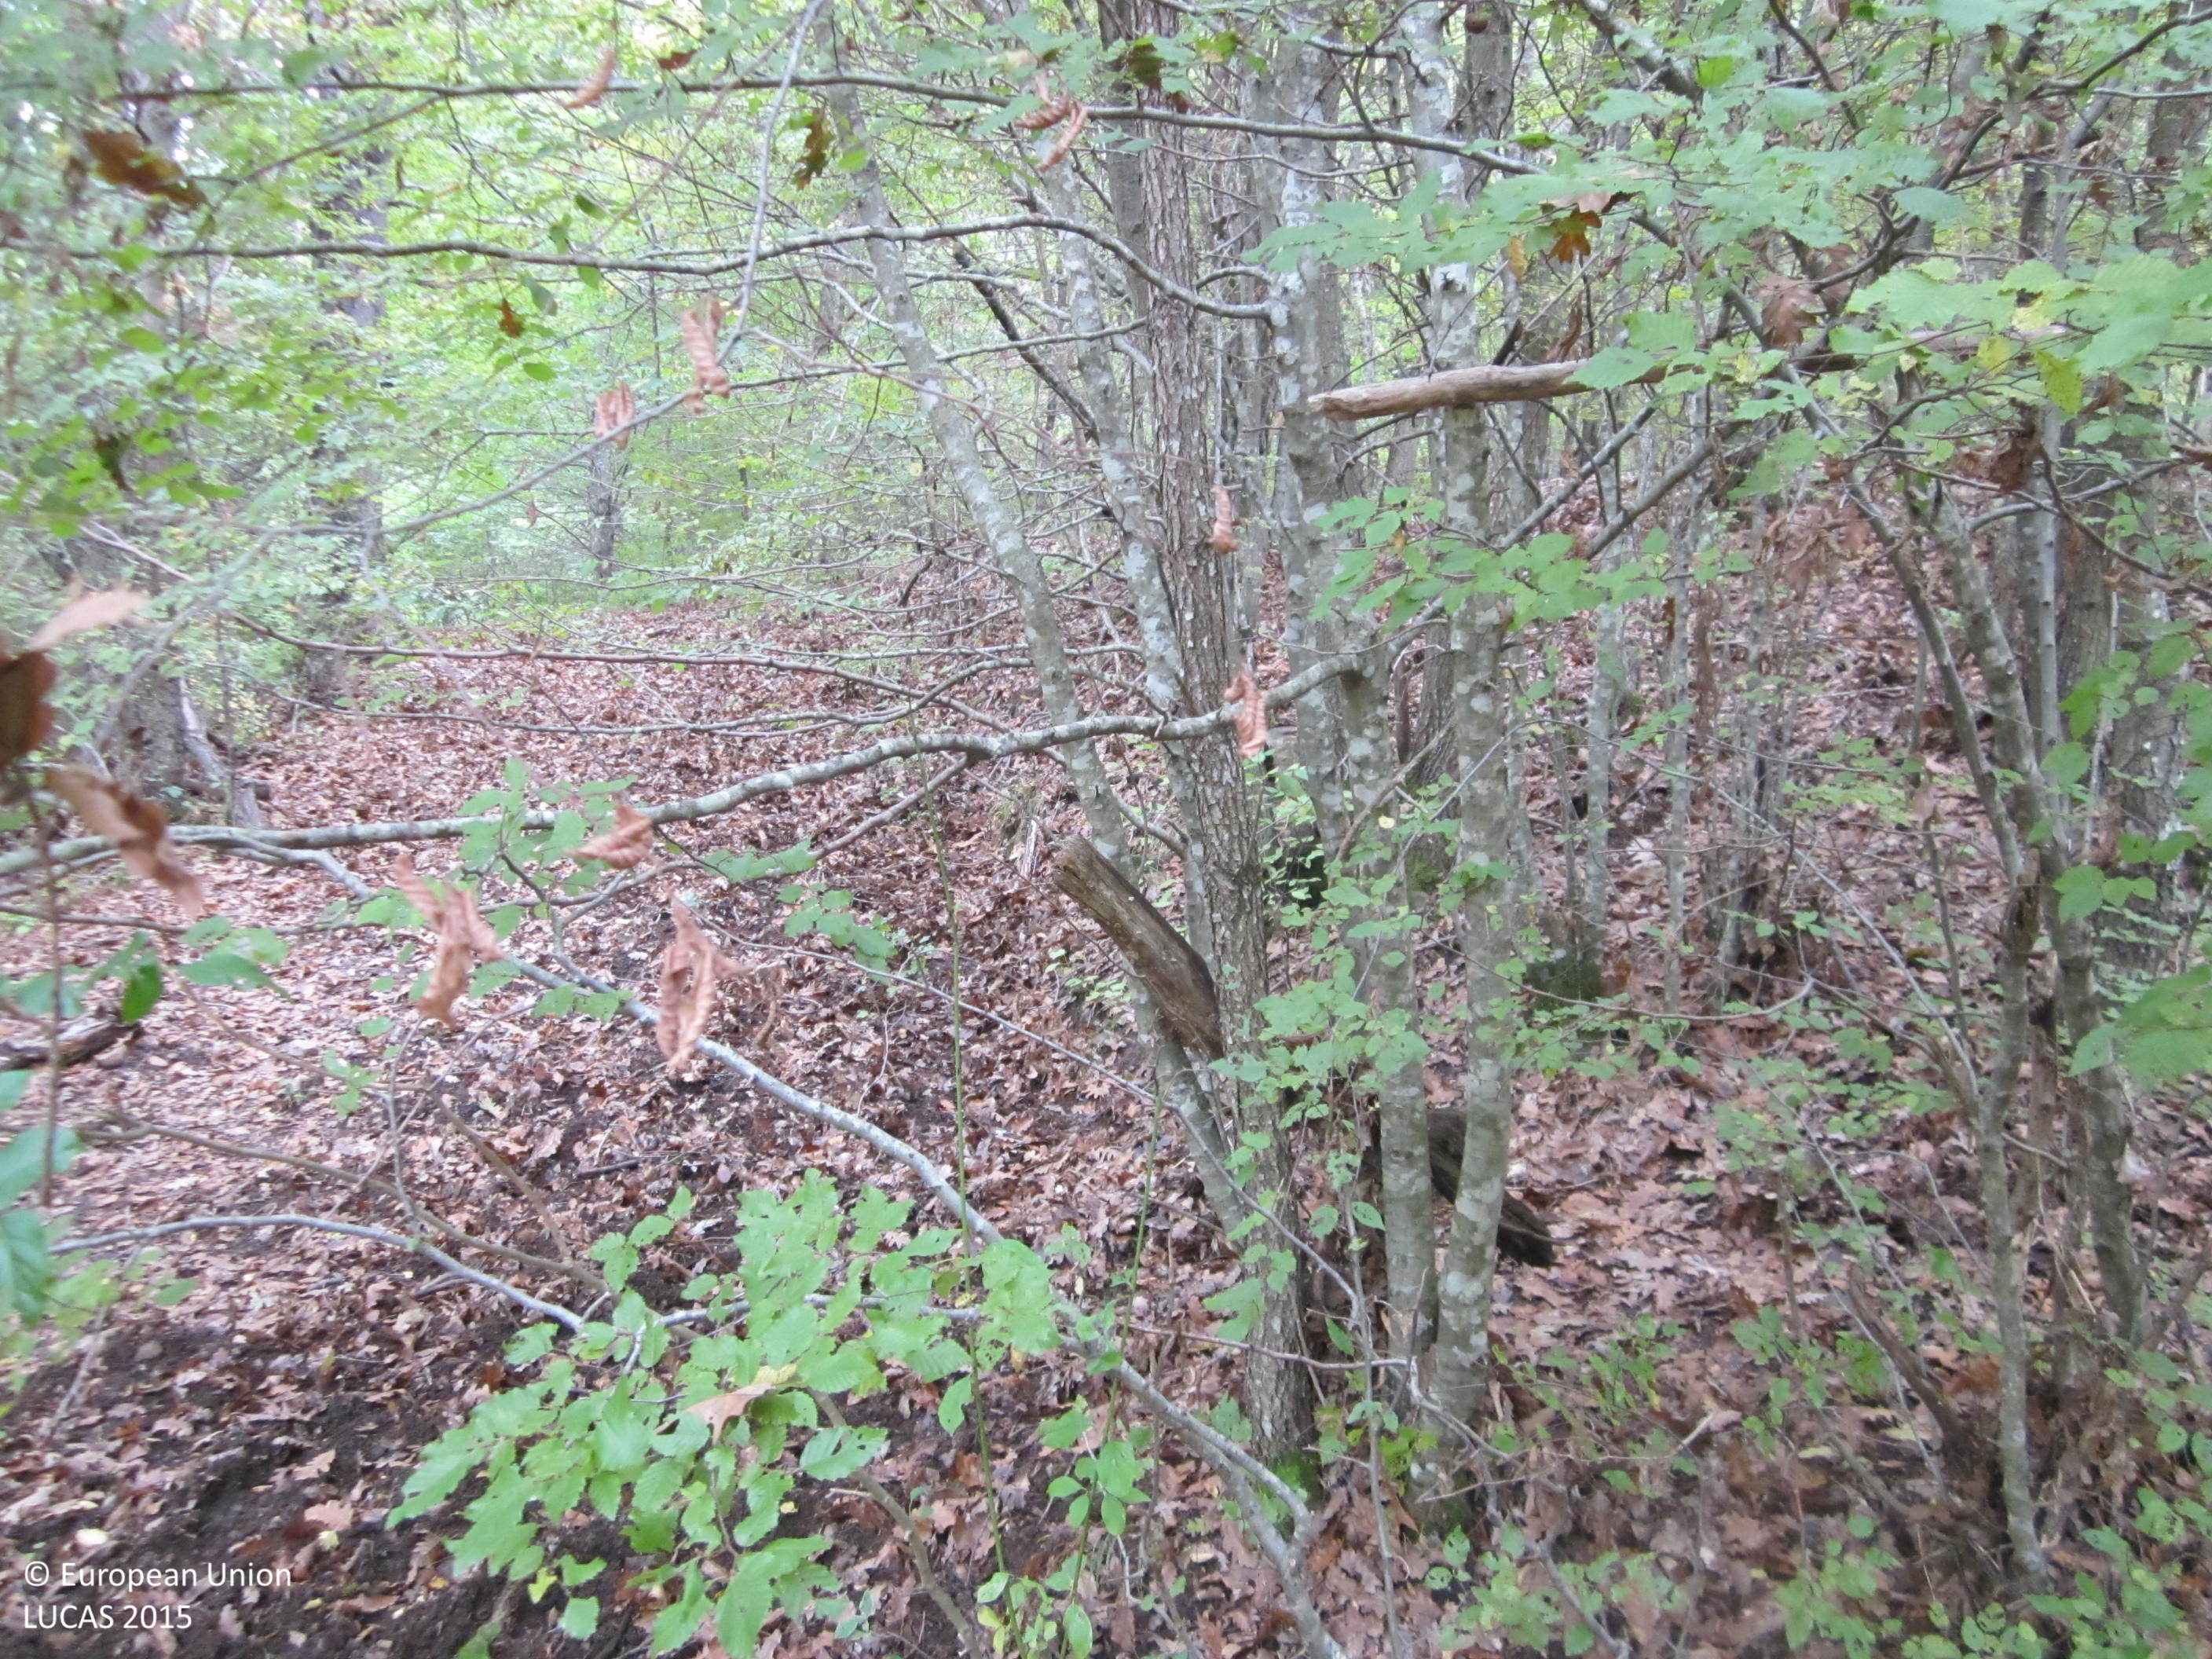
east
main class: Woodland
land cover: Broadleaved woodland
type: mesophytic deciduous forest
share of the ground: > 75 %
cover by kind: broadleaved forest trees 90 %, unconsolidated bare surface 10 %
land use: Forestry
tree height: > 5 m
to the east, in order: Broadleaved woodland
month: October
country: BG
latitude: 42.2569
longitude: 27.4096
